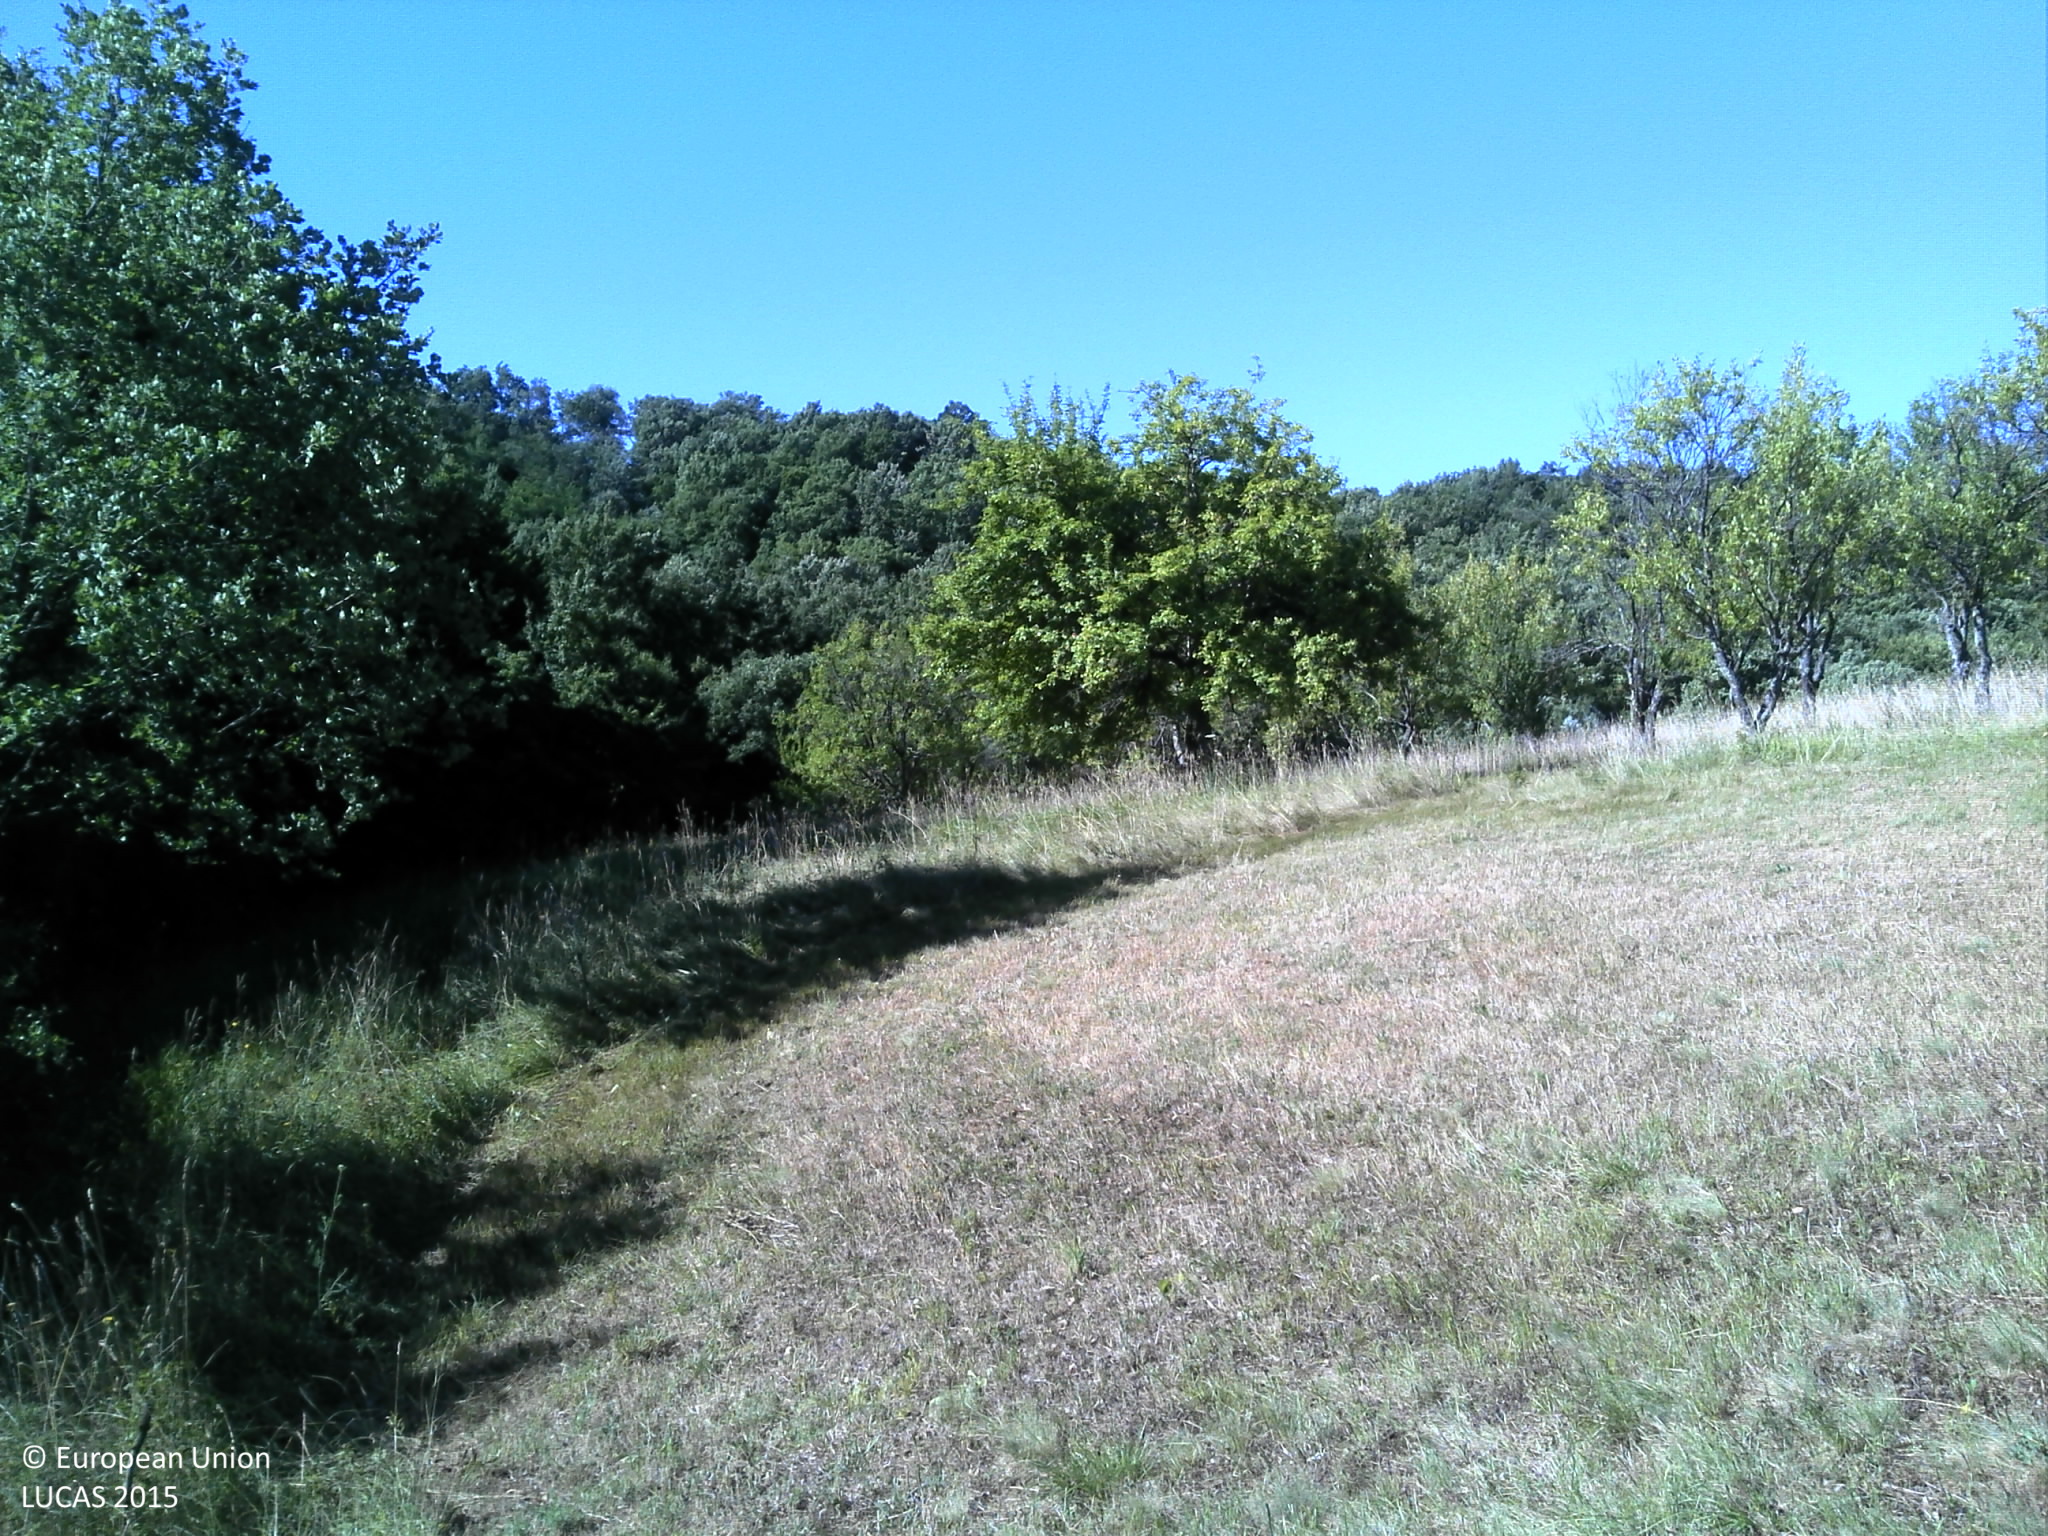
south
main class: Woodland
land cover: Broadleaved woodland
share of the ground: 25 - 50 %
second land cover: Grassland without tree/shrub cover
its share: > 75 %
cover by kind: herbaceous plants 65 %, broadleaved forest trees 25 %, shrubs 10 %
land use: Forestry
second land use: Agriculture (excluding fallow land and kitchen gardens)
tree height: < 5 m
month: July
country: HR
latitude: 44.1331
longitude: 16.1297
